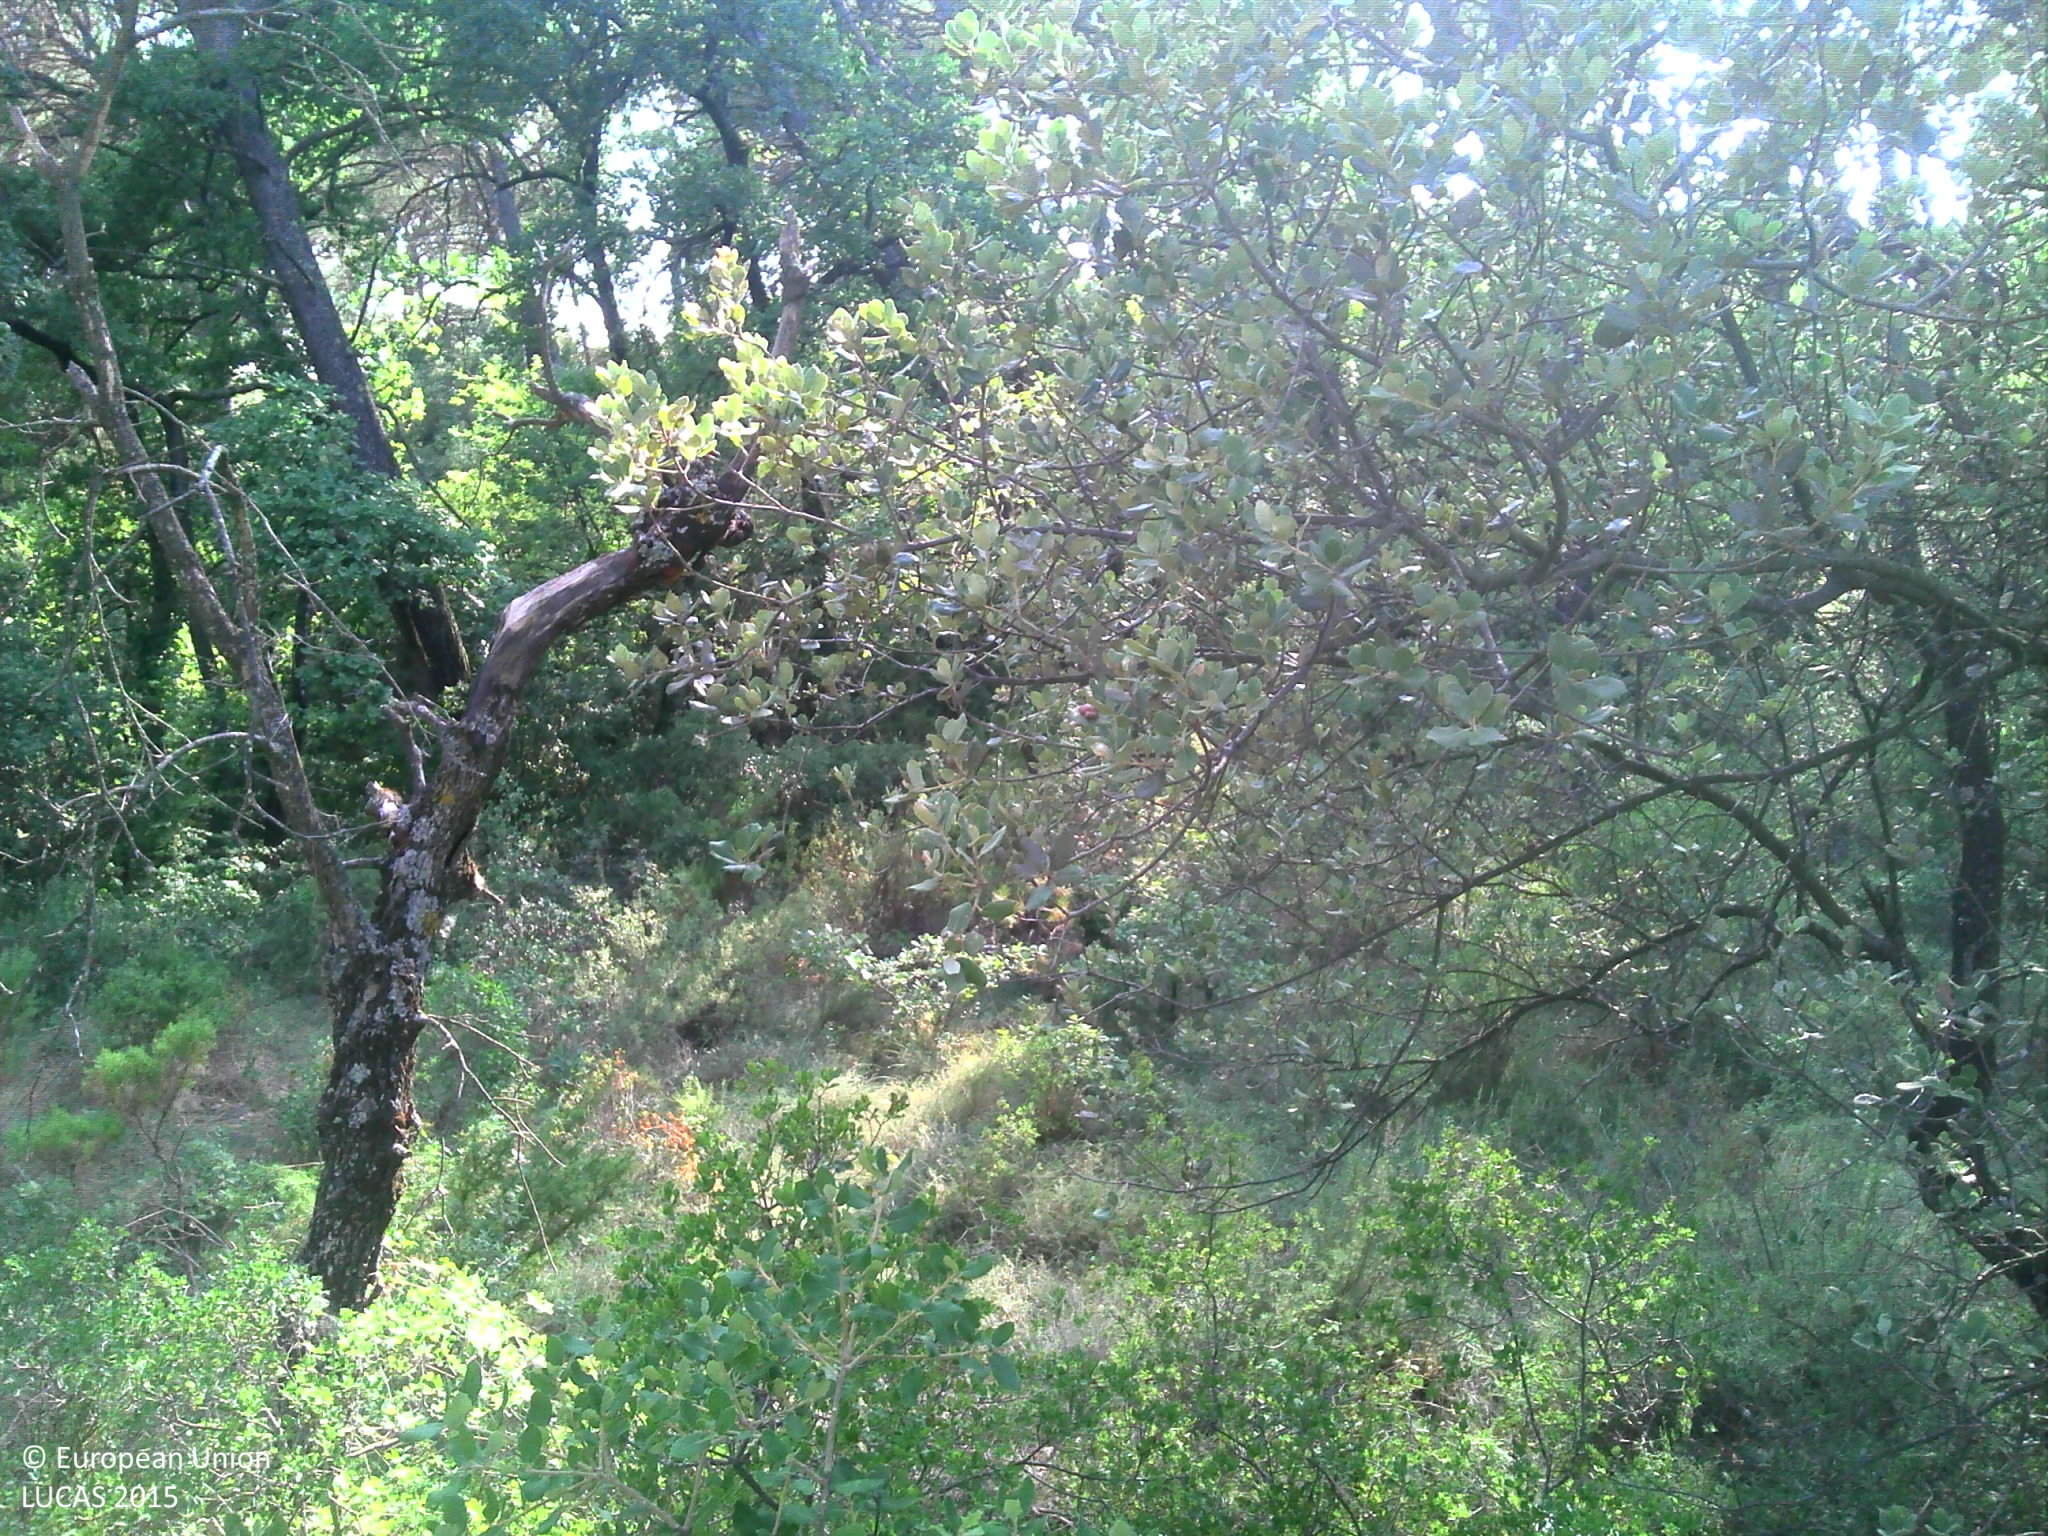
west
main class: Woodland
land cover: Pine dominated mixed woodland
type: coniferous forest of the mediterranean region
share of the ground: > 75 %
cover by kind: coniferous forest trees 40 %, broadleaved forest trees 35 %, shrubs 20 %, herbaceous plants 5 %
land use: Forestry
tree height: > 5 m
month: July
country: FR
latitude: 43.6855
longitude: 5.3324
